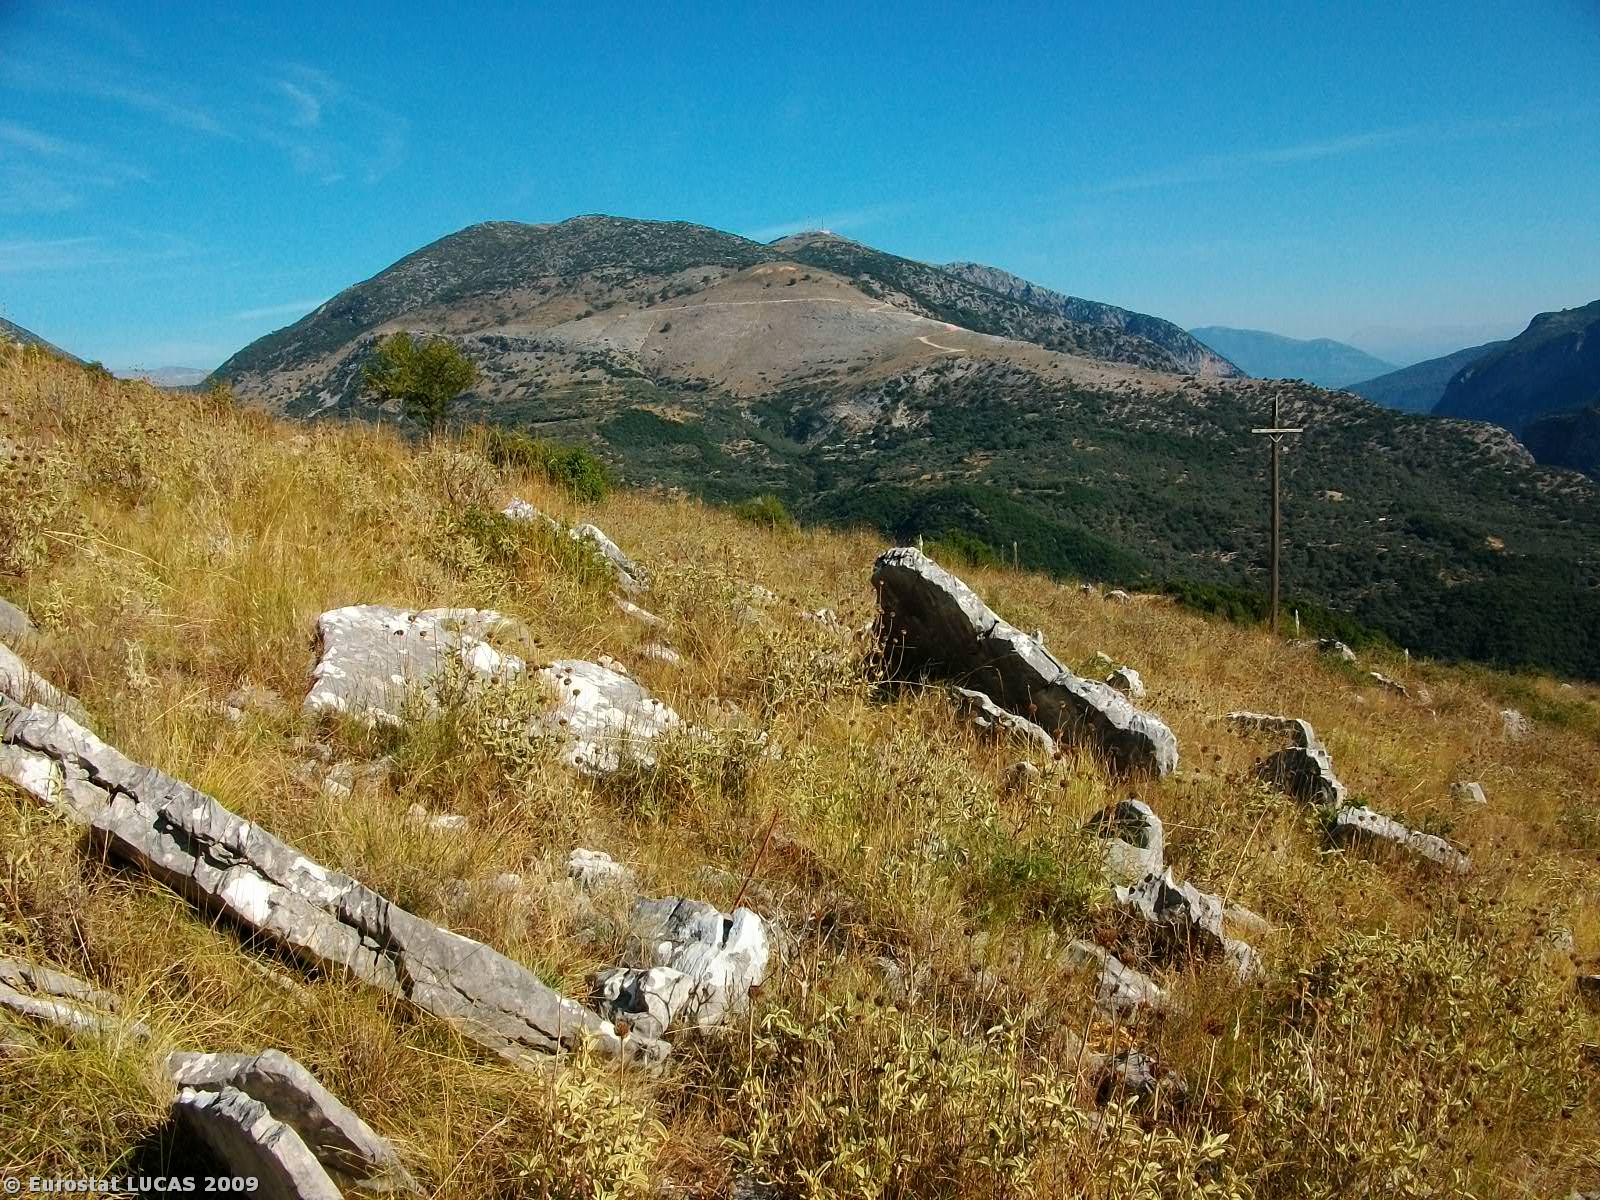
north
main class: Grassland
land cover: Grassland with sparse tree/shrub cover
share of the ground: 50 - 75 %
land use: Agriculture (excluding fallow land and kitchen gardens)
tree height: < 5 m
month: September
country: GR
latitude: 39.5809
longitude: 20.4420
